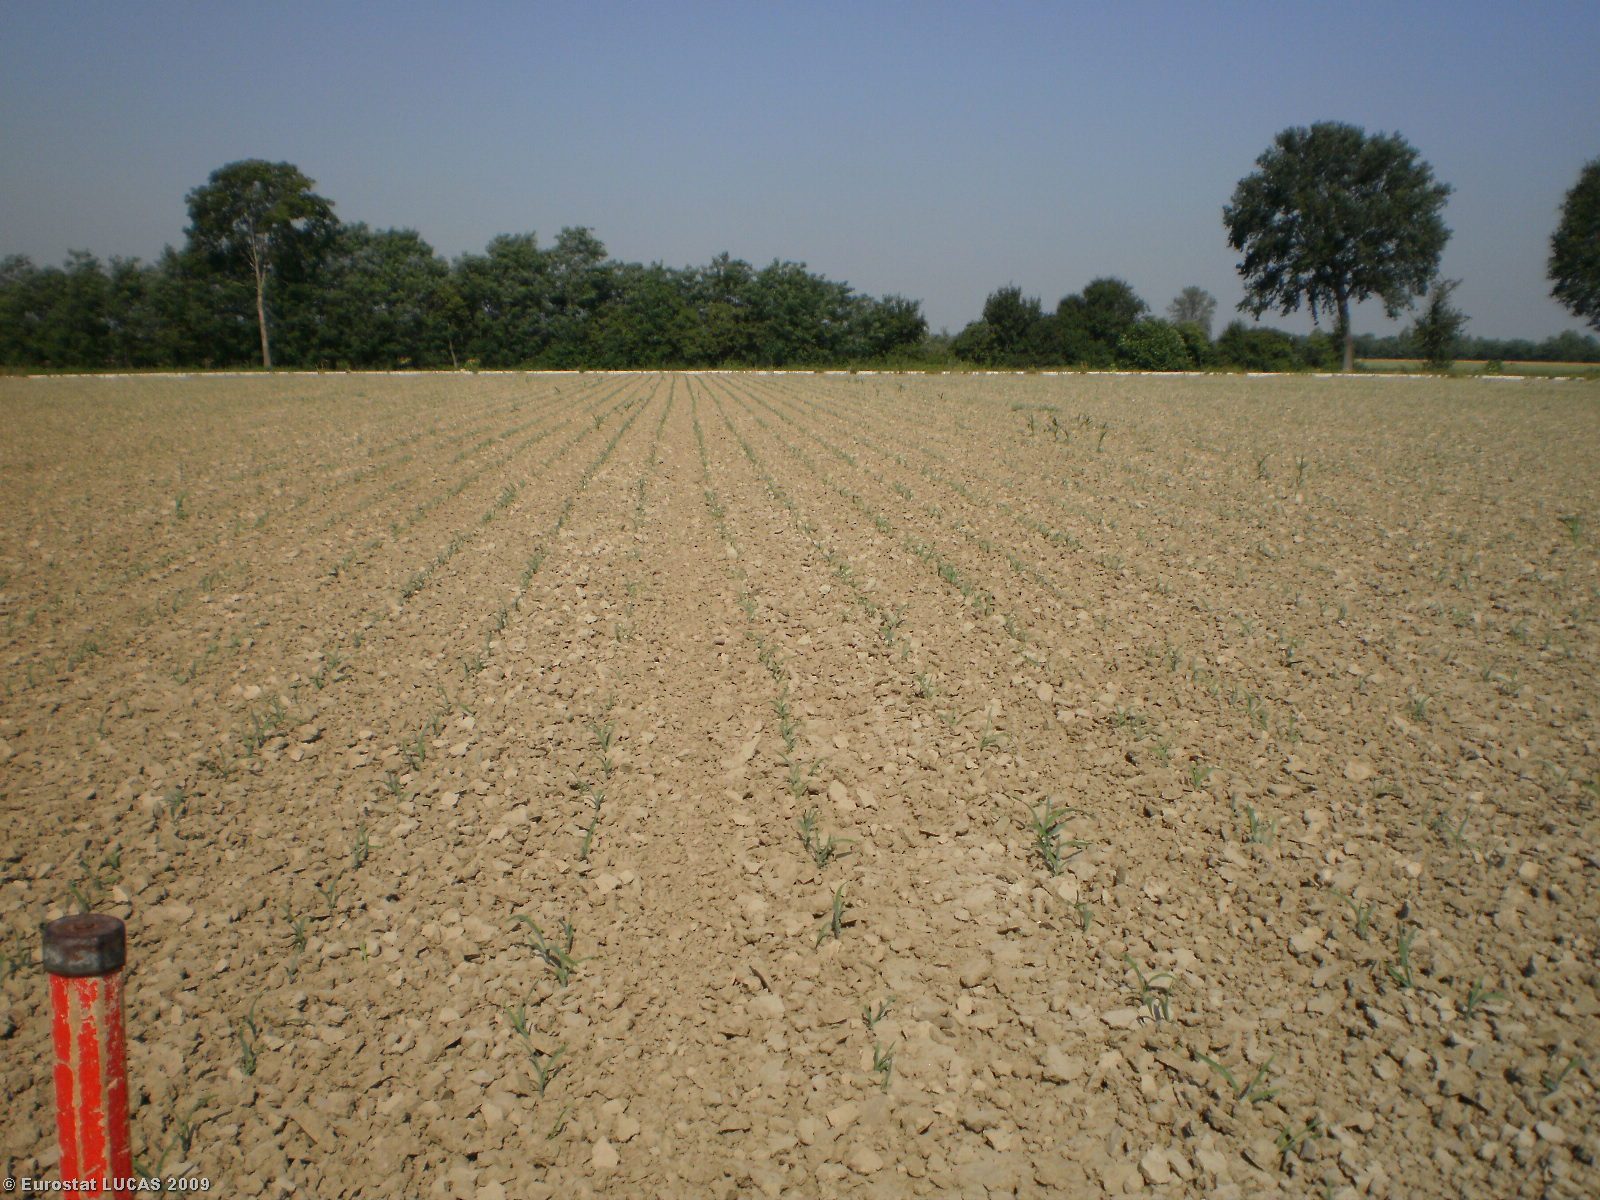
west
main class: Cropland
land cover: Maize
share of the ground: 10 - 25 %
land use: Agriculture (excluding fallow land and kitchen gardens)
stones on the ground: < 10 %
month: June
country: IT
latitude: 45.1614
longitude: 10.3428
